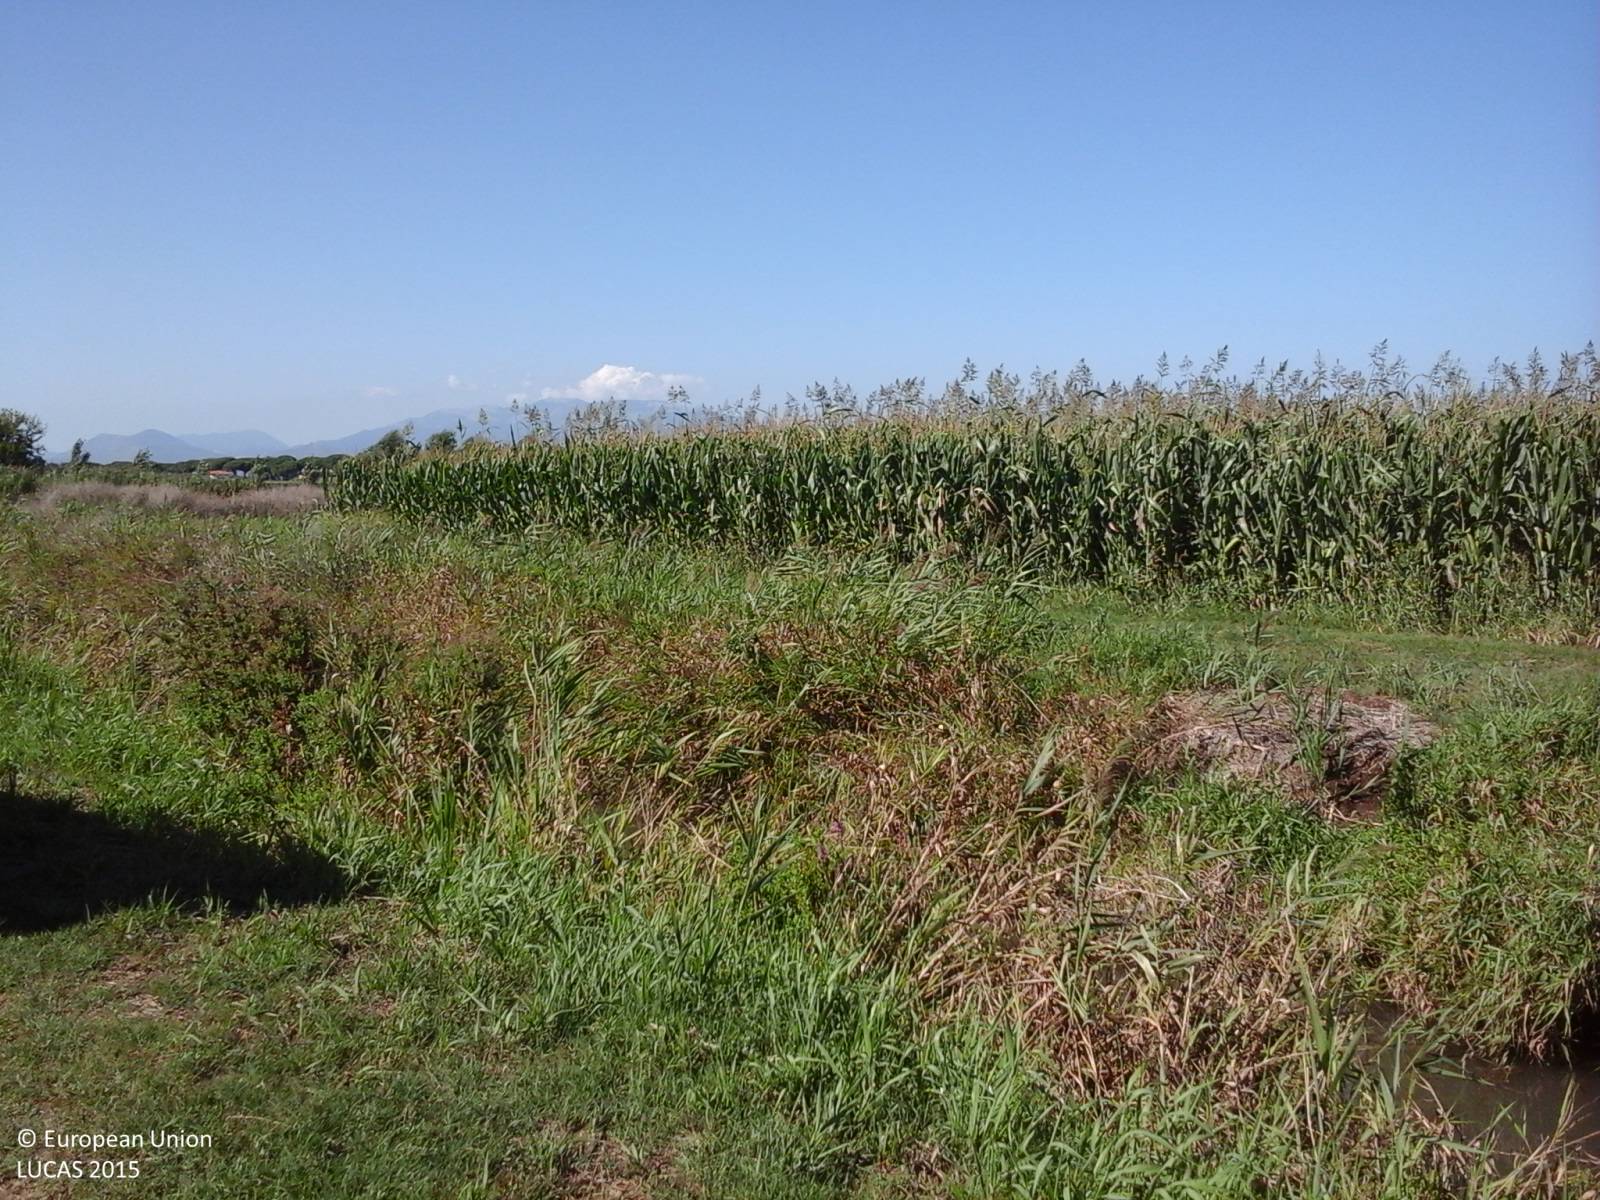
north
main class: Cropland
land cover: Maize
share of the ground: > 75 %
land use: Agriculture (excluding fallow land and kitchen gardens)
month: August
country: IT
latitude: 41.3391
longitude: 13.1540
